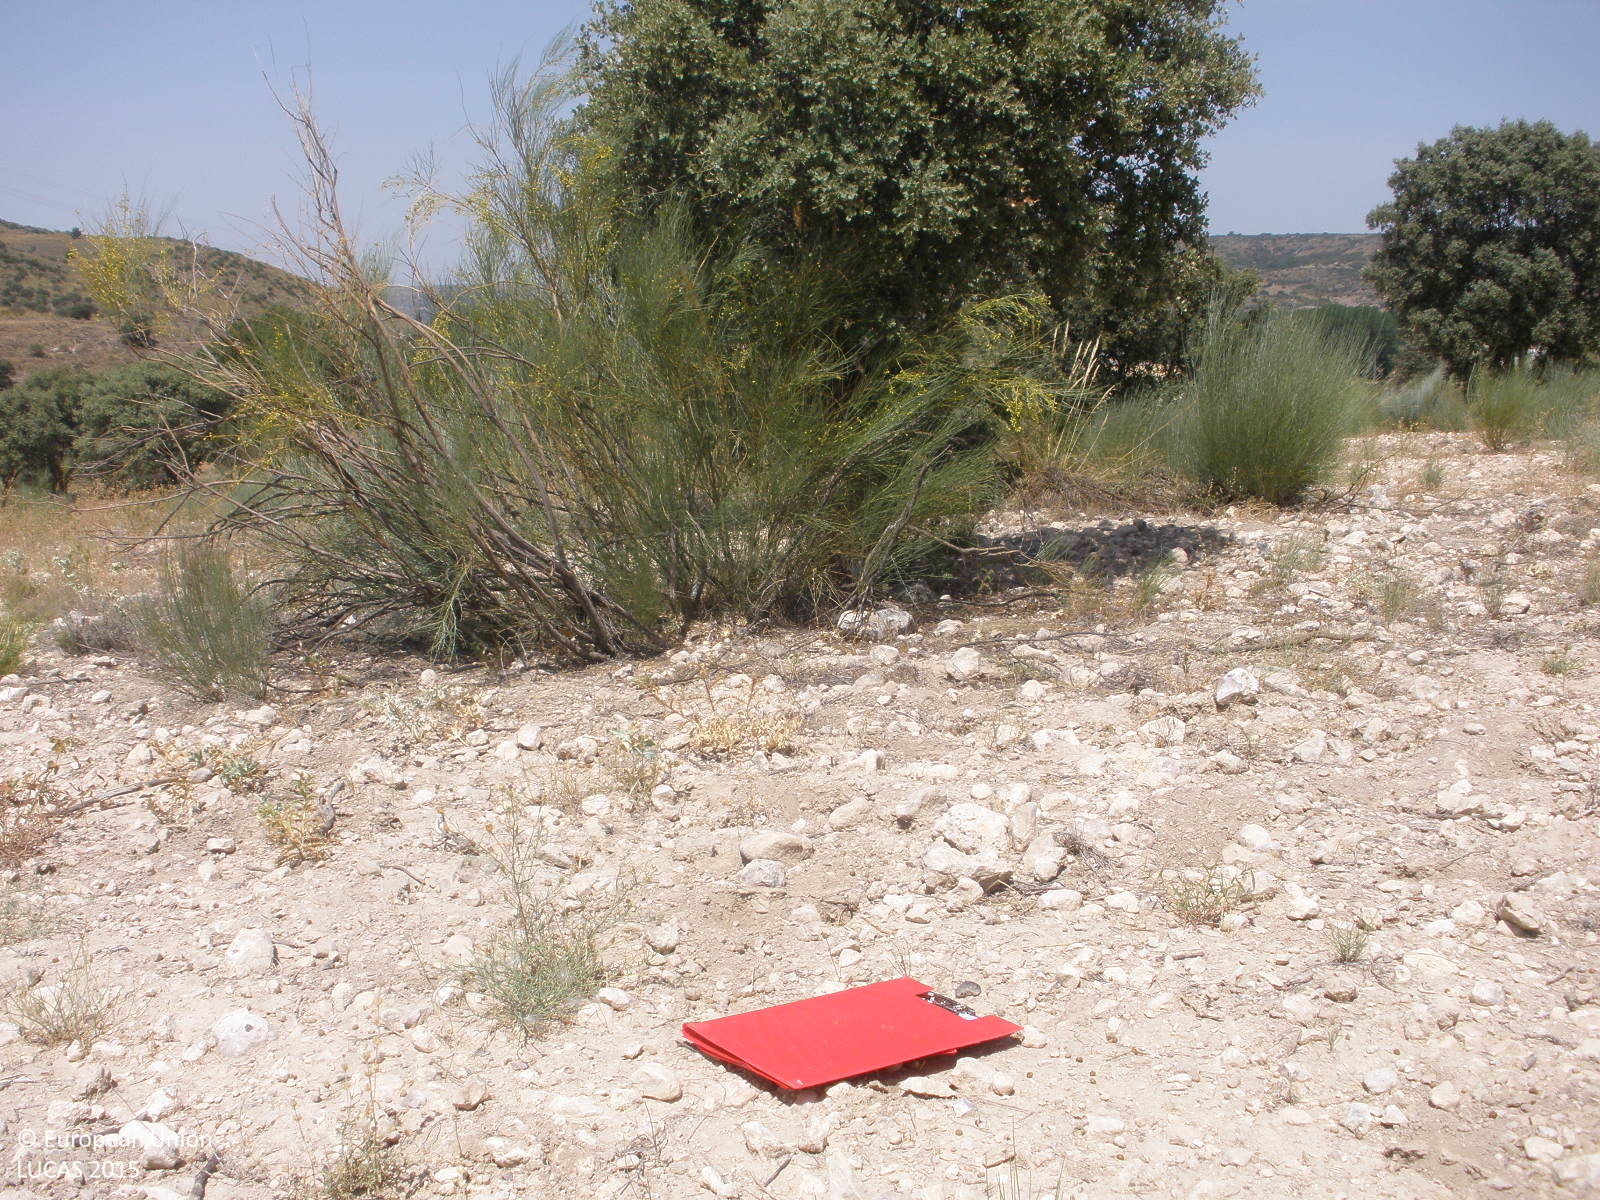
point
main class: Shrubland
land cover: Shrubland with sparse tree cover
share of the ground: 50 - 75 %
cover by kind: shrubs 50 %, consolidated bare surface 30 %, herbaceous plants 15 %, broadleaved forest trees 5 %
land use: Semi-natural and natural areas not in use
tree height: < 5 m
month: July
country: ES
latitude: 40.2234
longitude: -3.3927
